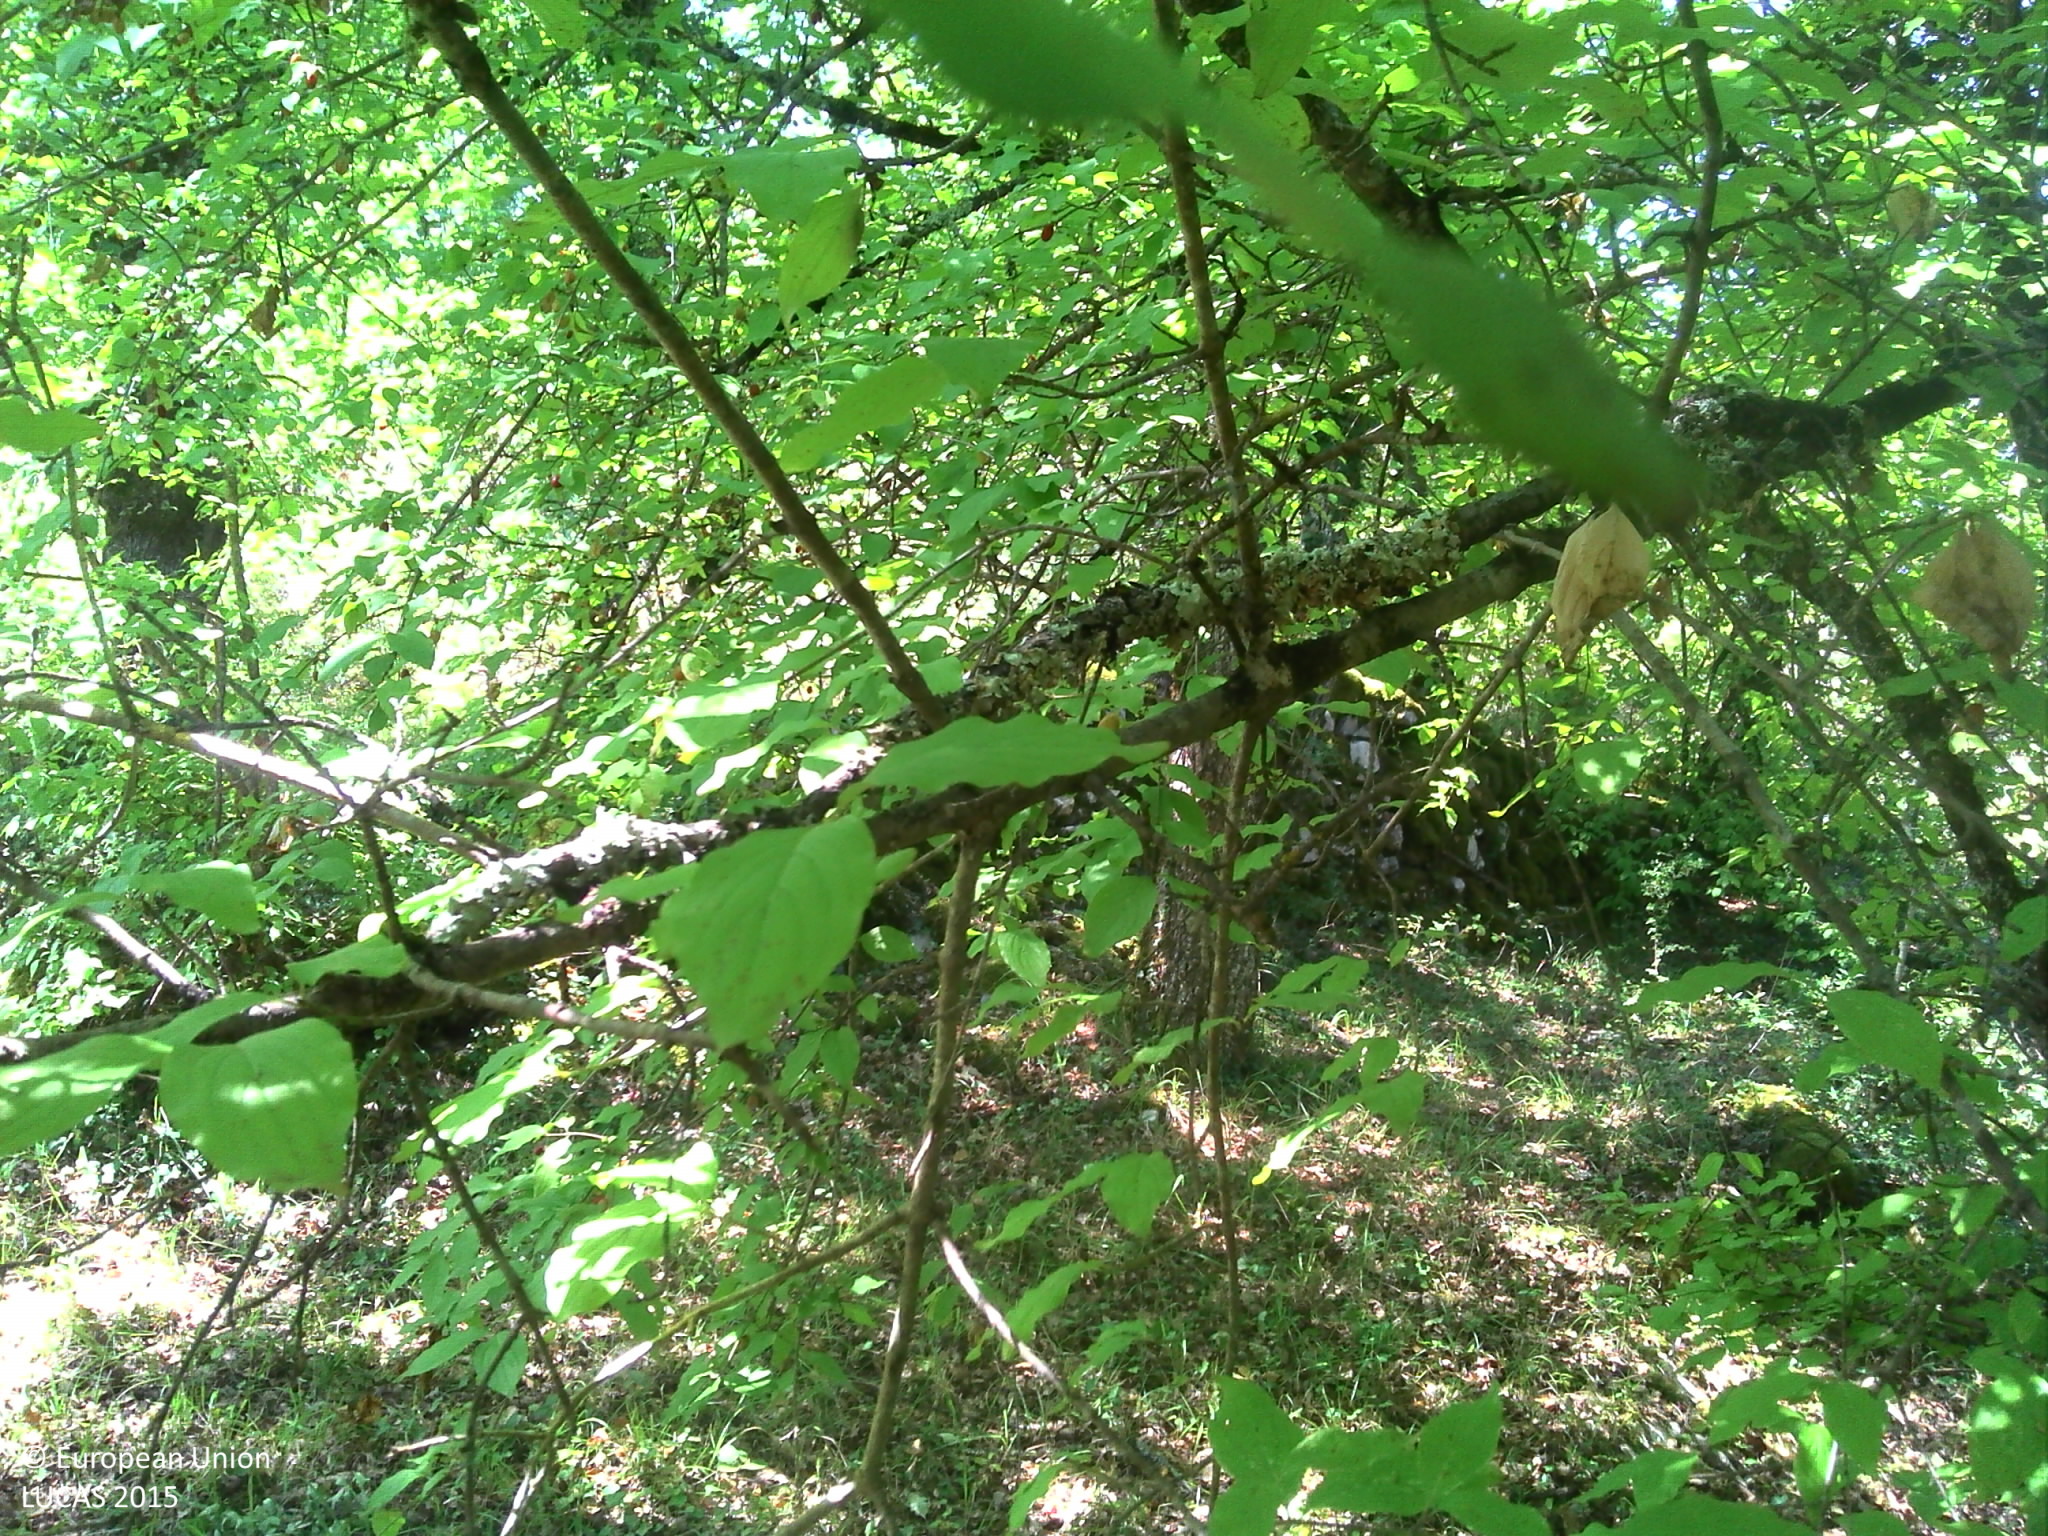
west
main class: Woodland
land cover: Broadleaved woodland
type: mesophytic deciduous forest
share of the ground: > 75 %
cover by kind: broadleaved forest trees 60 %, shrubs 30 %, herbaceous plants 10 %
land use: Forestry
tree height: > 5 m
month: August
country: FR
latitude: 44.7306
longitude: 1.7784
